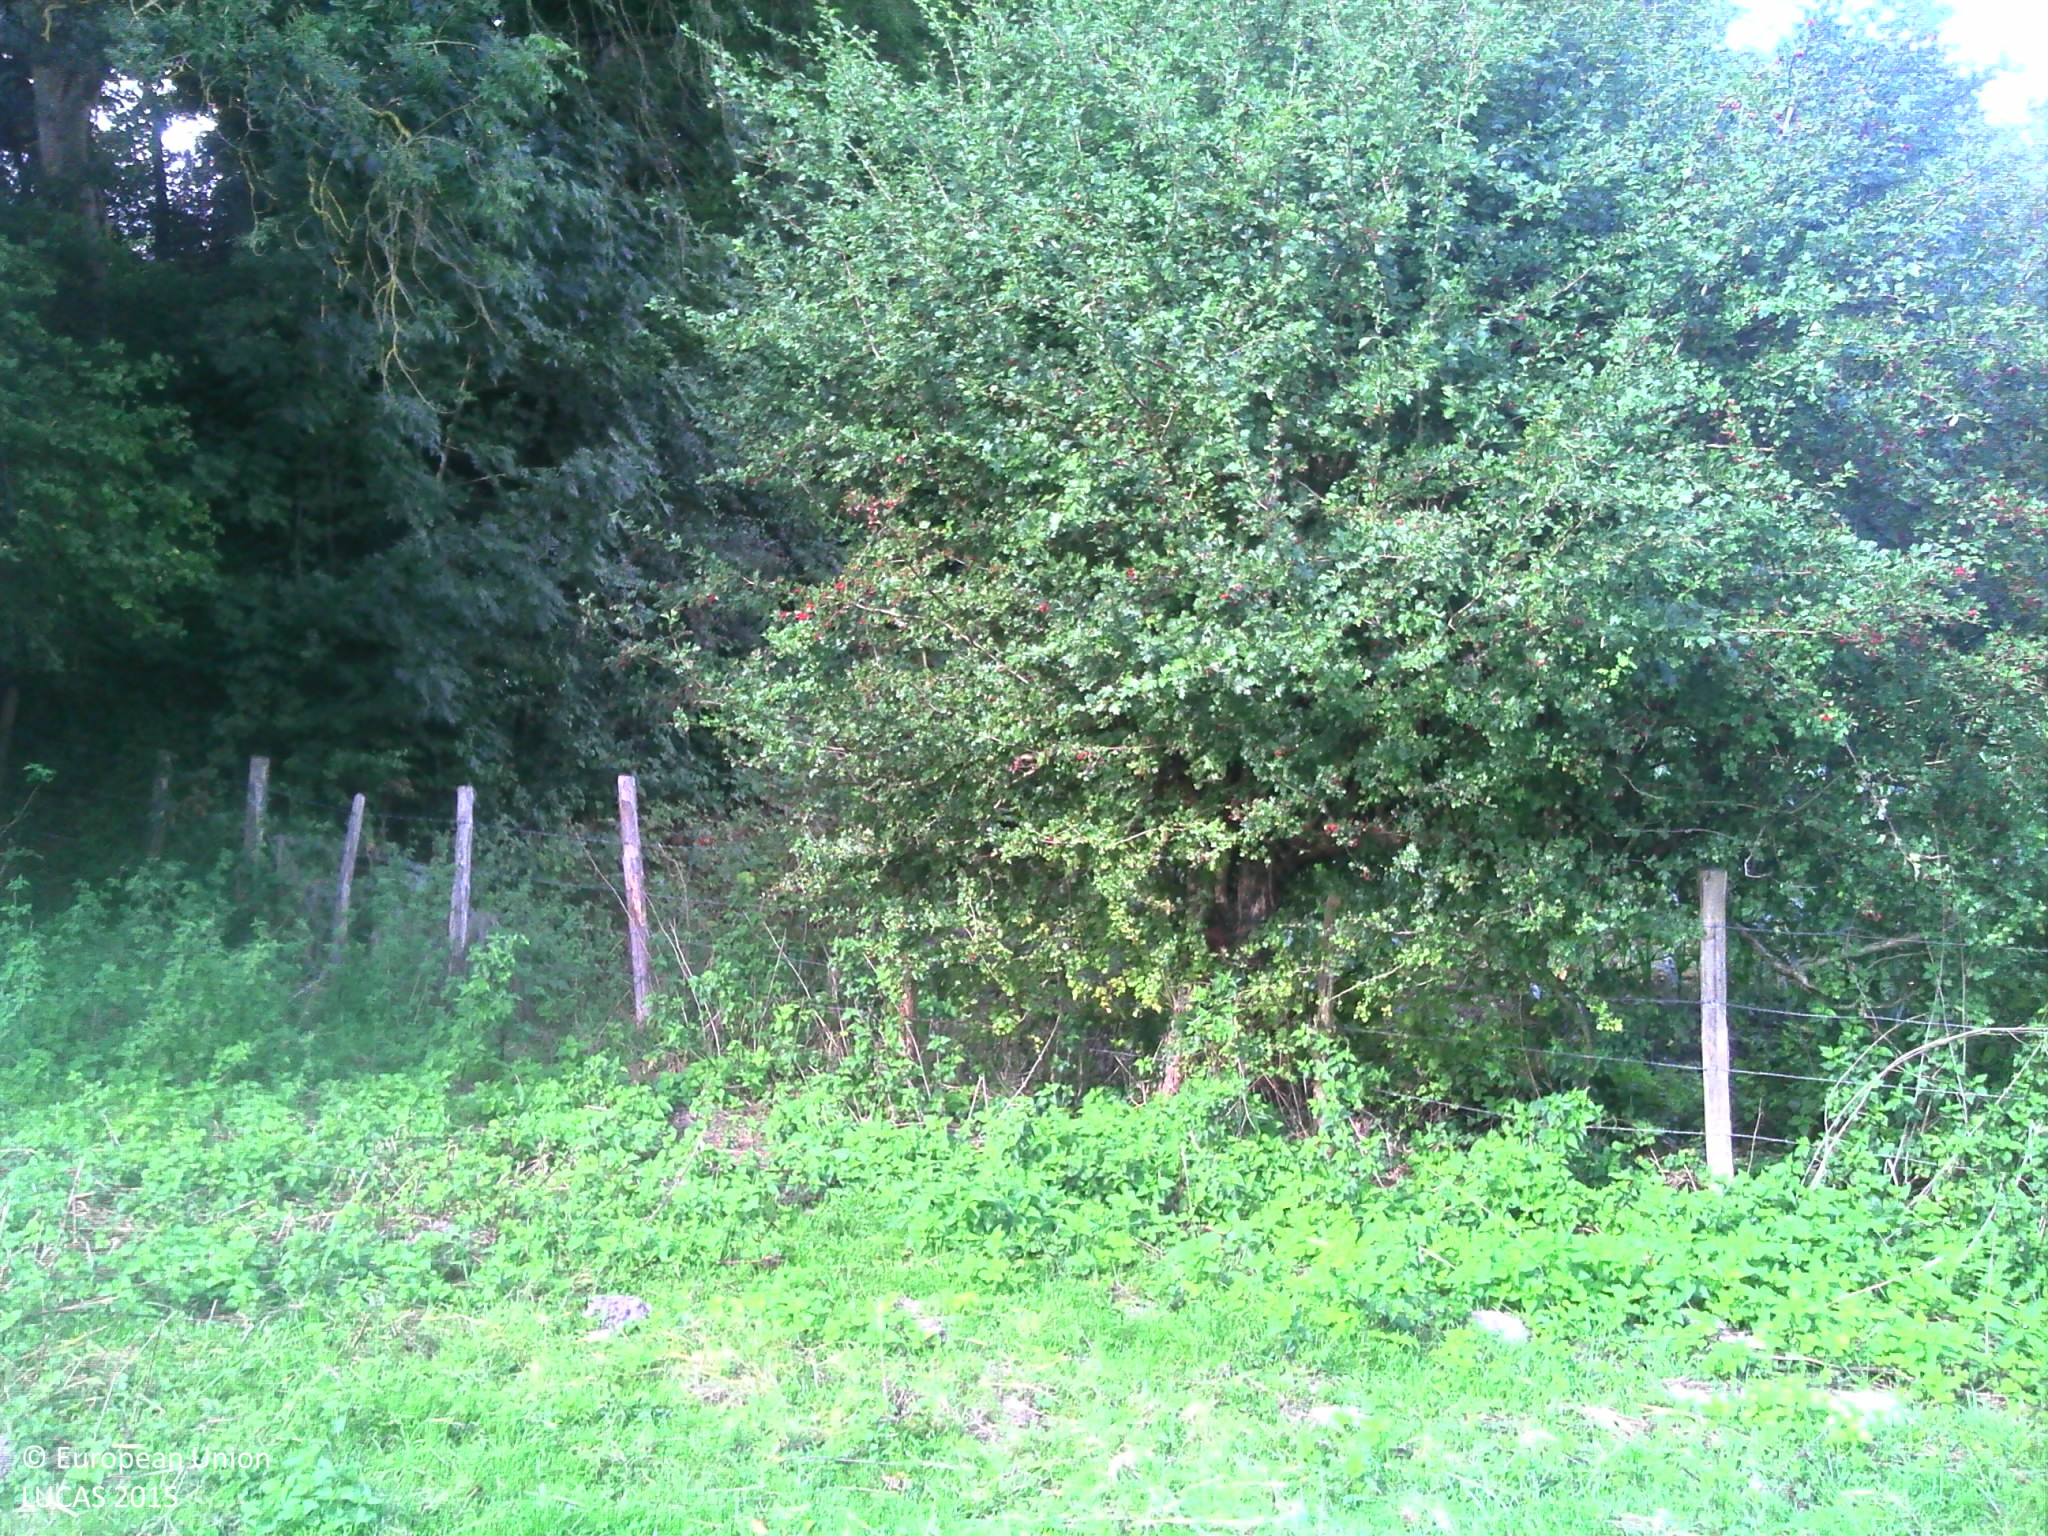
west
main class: Cropland
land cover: Maize
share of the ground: > 75 %
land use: Agriculture (excluding fallow land and kitchen gardens)
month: September
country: FR
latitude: 48.4001
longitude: 0.8067
